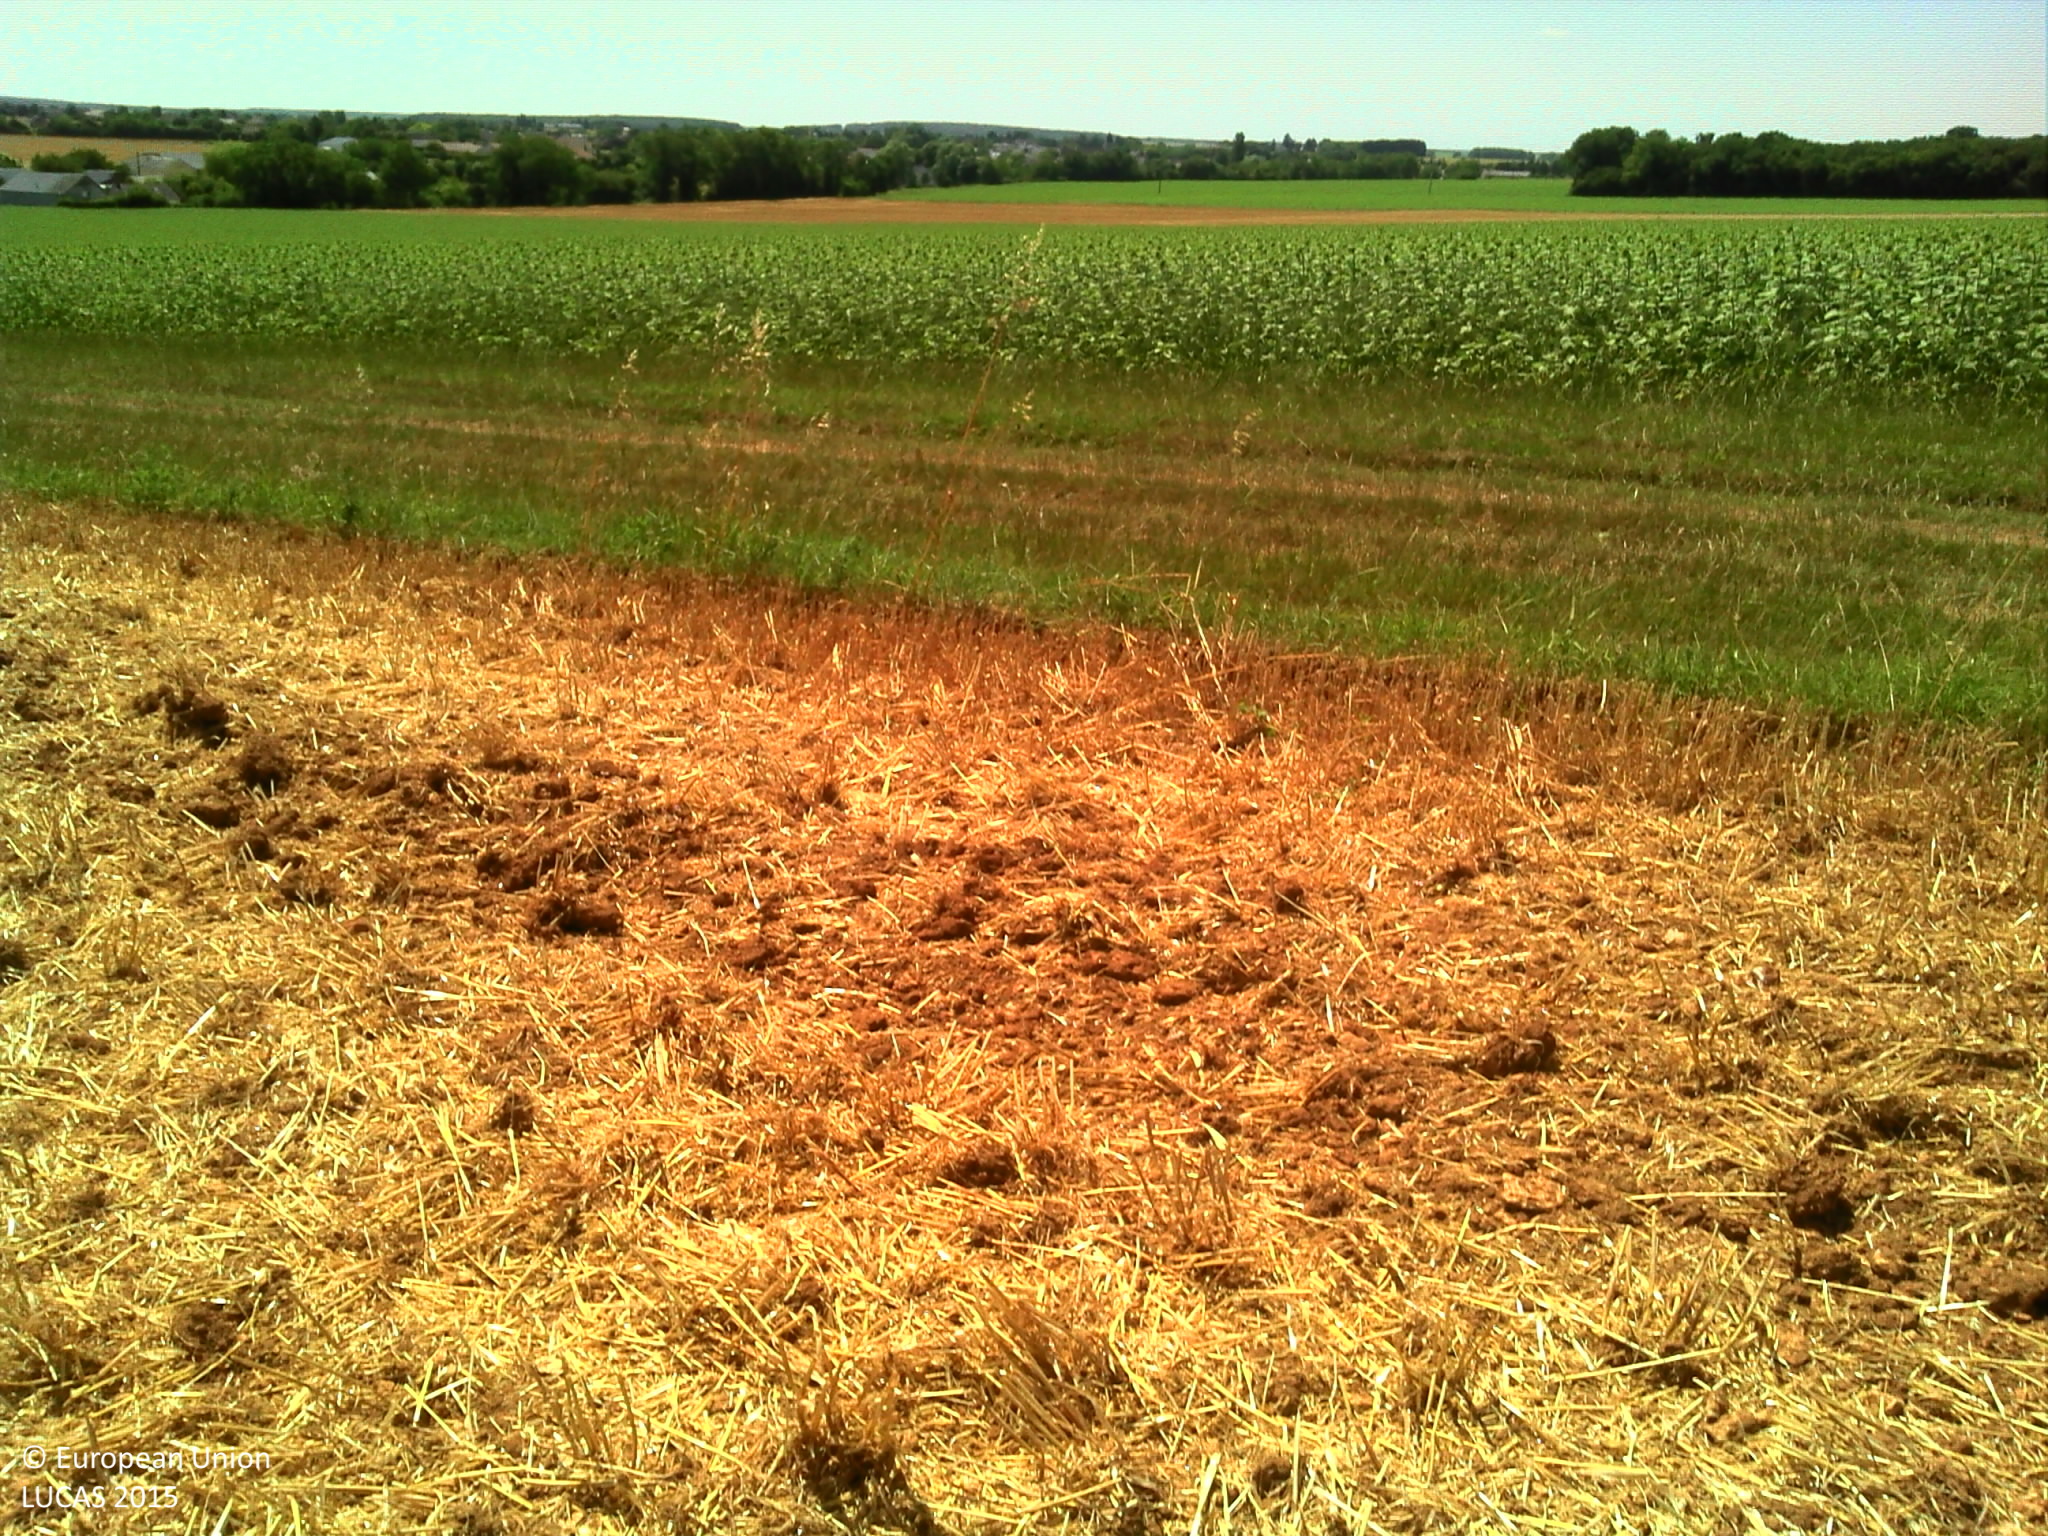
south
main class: Cropland
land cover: Barley
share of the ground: > 75 %
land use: Agriculture (excluding fallow land and kitchen gardens)
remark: Harvested field
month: June
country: FR
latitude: 47.1986
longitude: 2.6146
